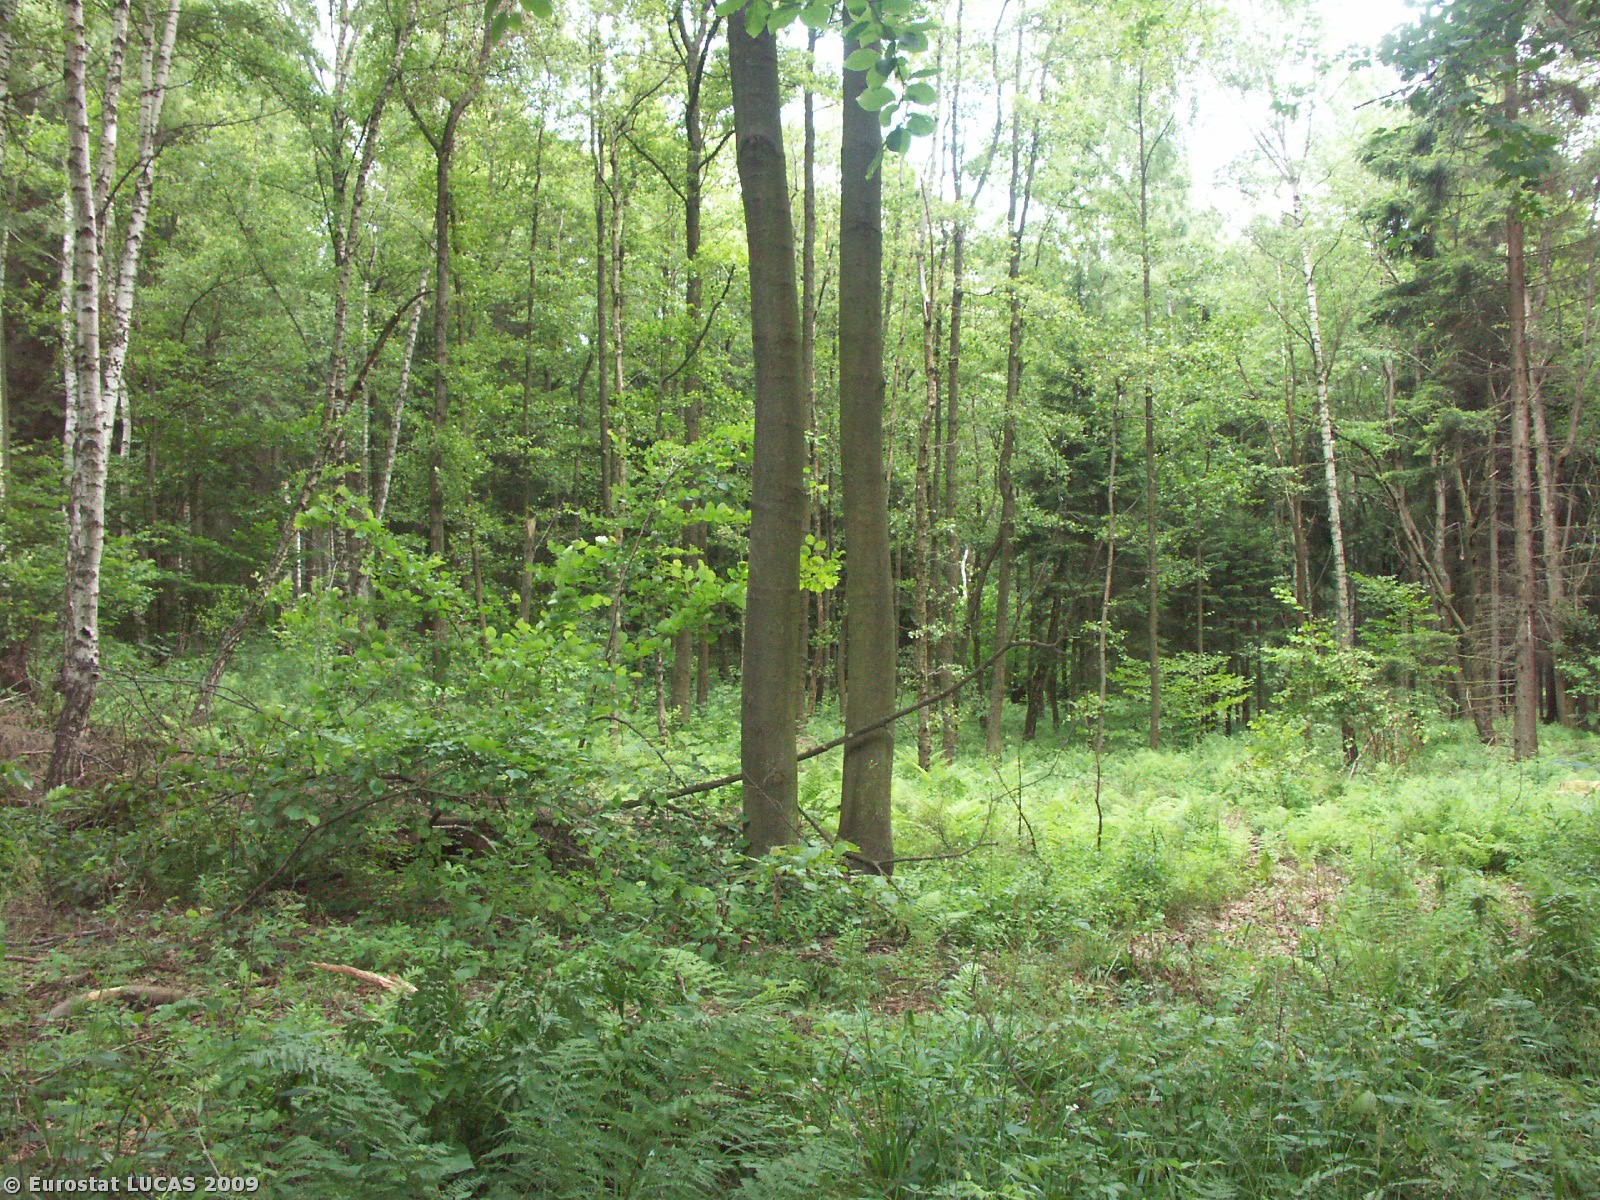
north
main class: Woodland
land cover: Mixed woodland
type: hemiboreal forest and nemoral coniferous forest and mixed broadleaved-coniferous forest
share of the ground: > 75 %
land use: Forestry
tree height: > 5 m
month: July
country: CZ
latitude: 49.8586
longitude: 17.5939
